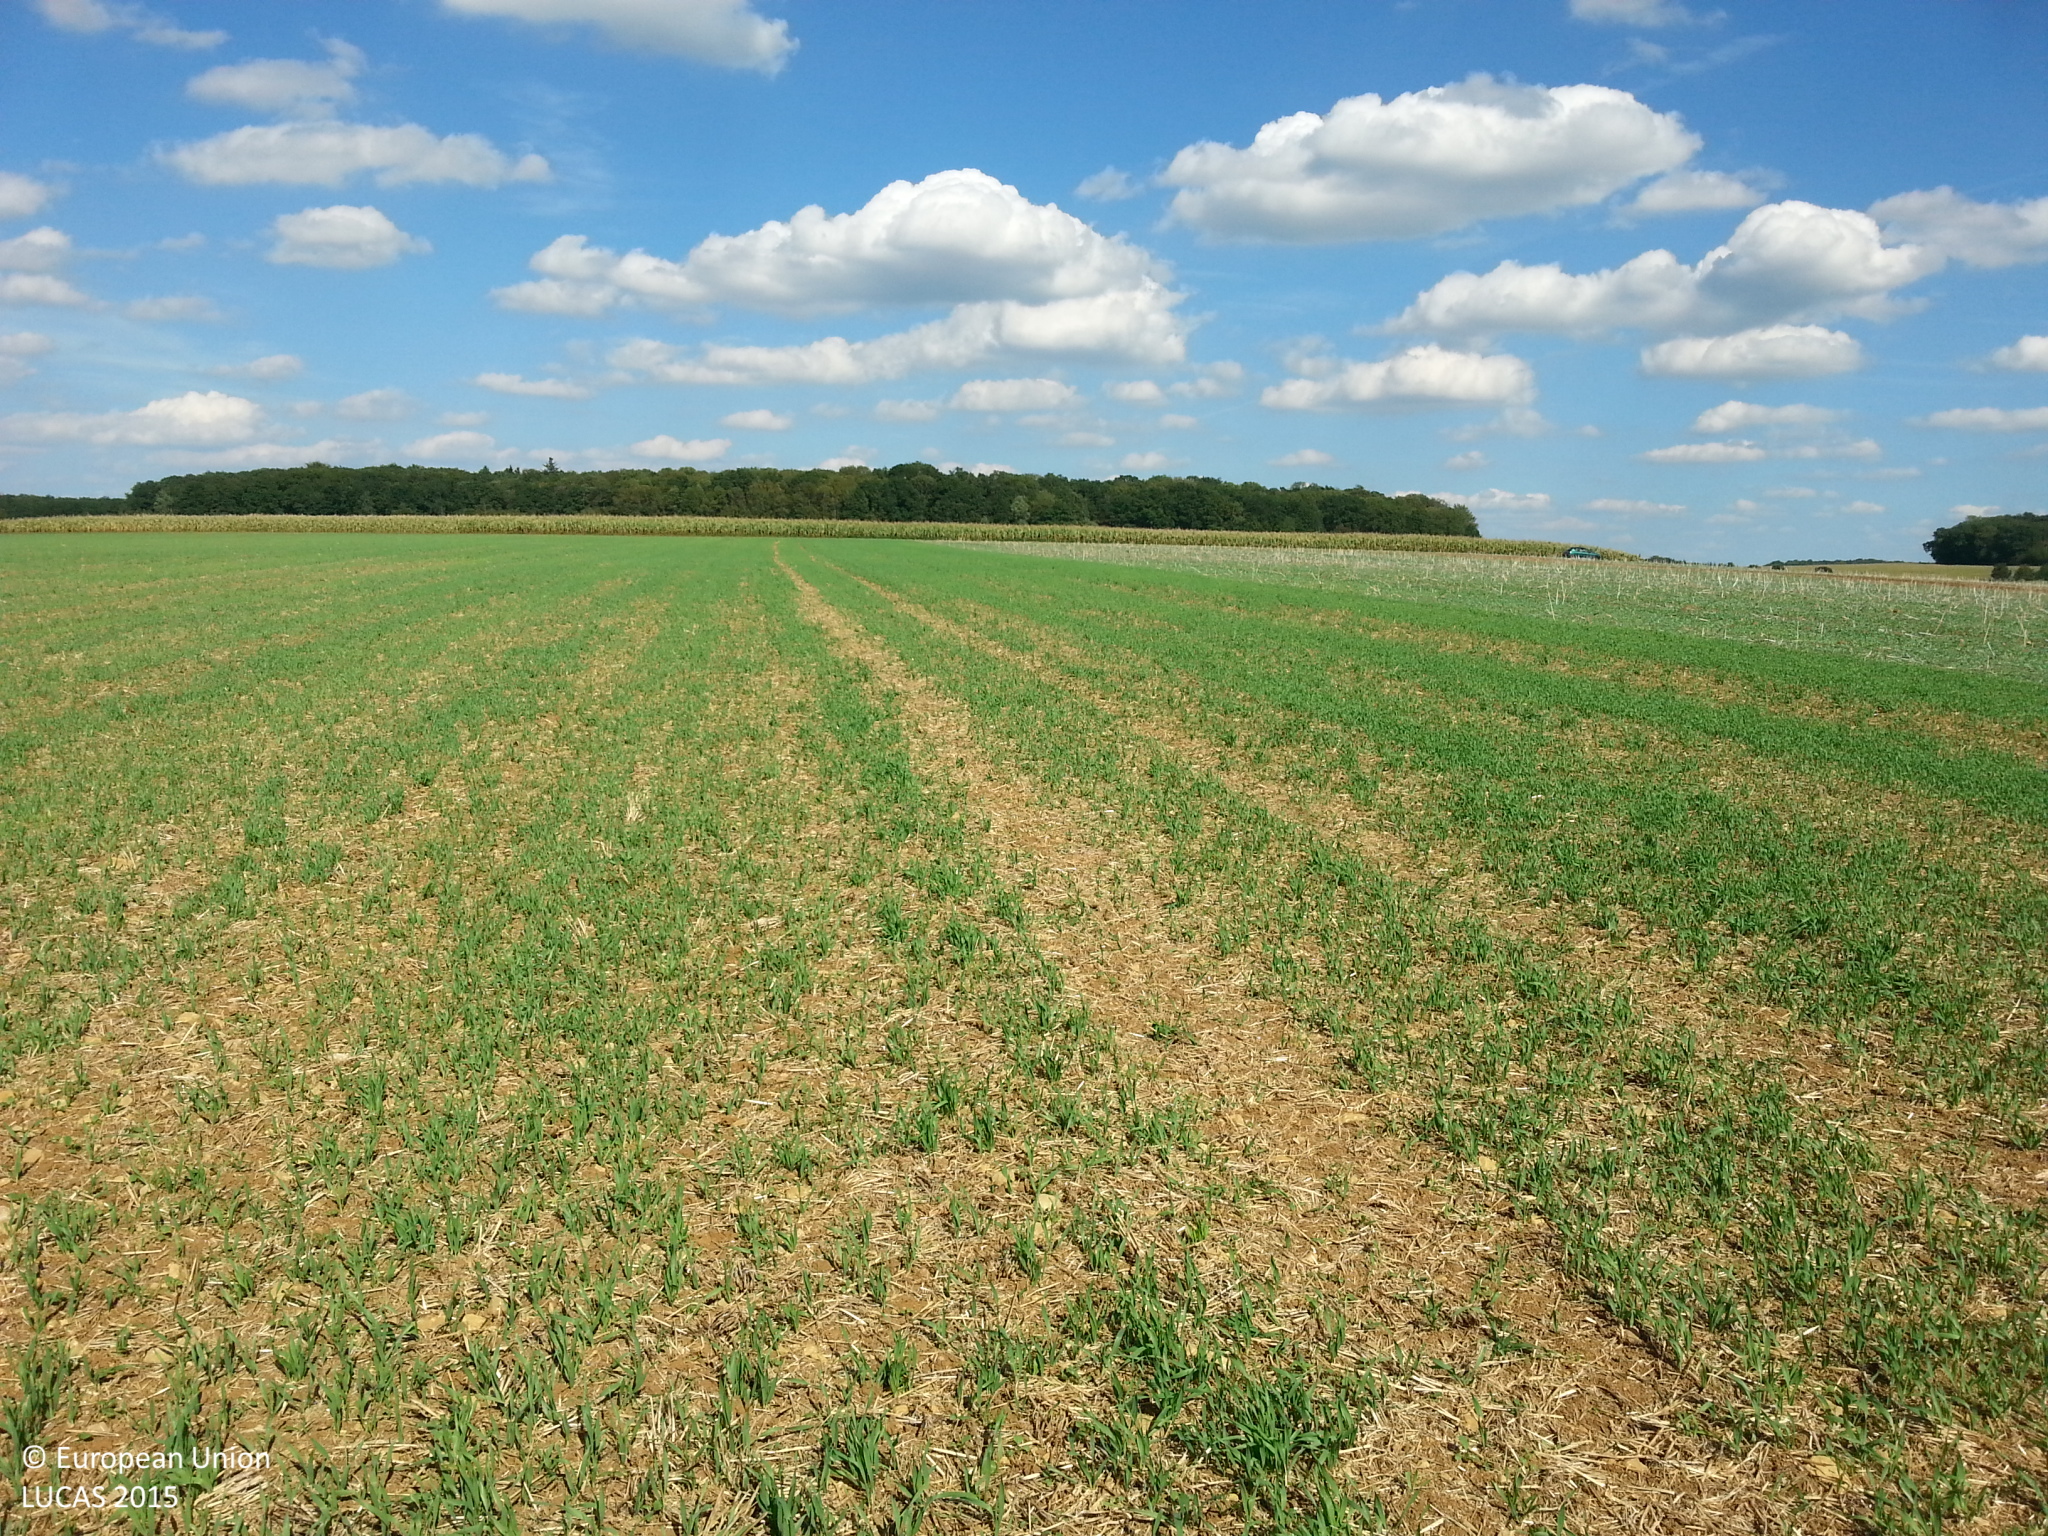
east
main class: Cropland
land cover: Temporary grasslands
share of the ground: 50 - 75 %
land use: Agriculture (excluding fallow land and kitchen gardens)
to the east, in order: Temporary grasslands; Other leguminous and mixtures for fodder; Rape and turnip rape; Other leguminous and mixtures for fodder; Tracks; Other bare soil
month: August
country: DE
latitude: 49.4289
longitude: 9.9587
